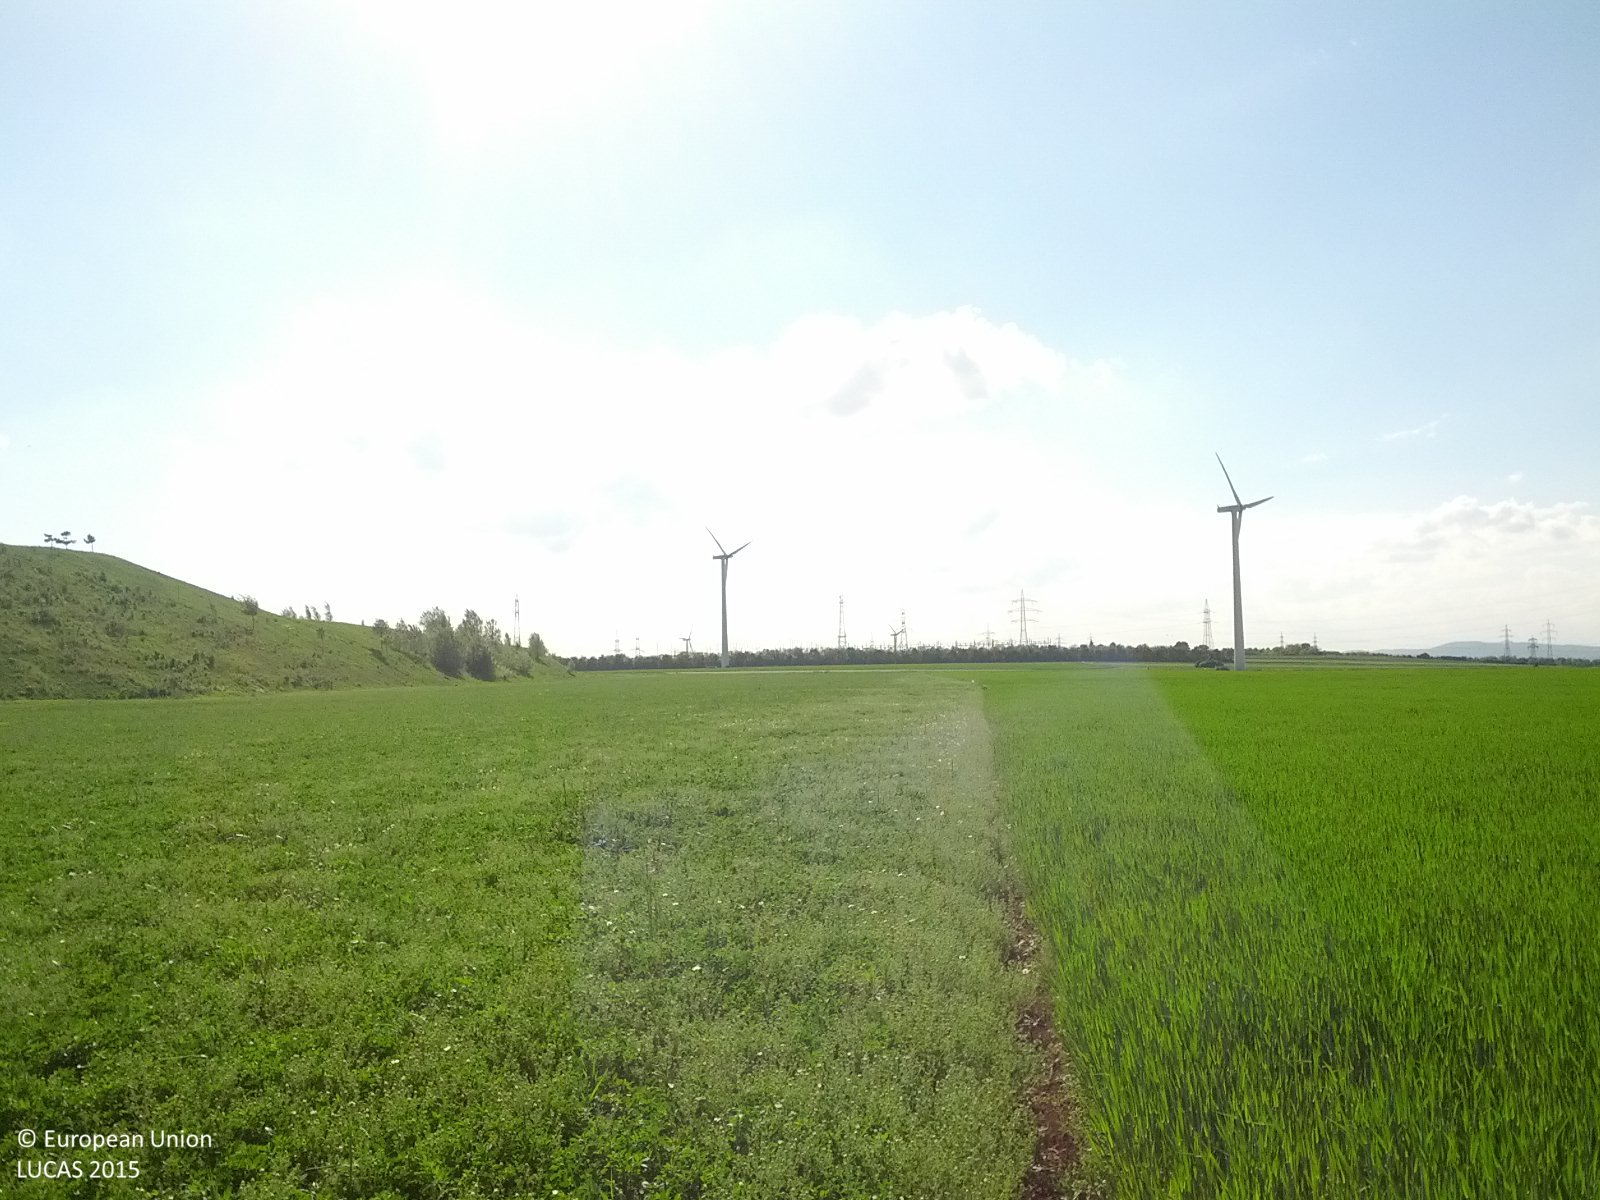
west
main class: Cropland
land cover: Lucerne
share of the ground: 50 - 75 %
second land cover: Other leguminous and mixtures for fodder
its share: 50 - 75 %
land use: Agriculture (excluding fallow land and kitchen gardens)
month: May
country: AT
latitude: 48.1254
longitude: 16.4405
